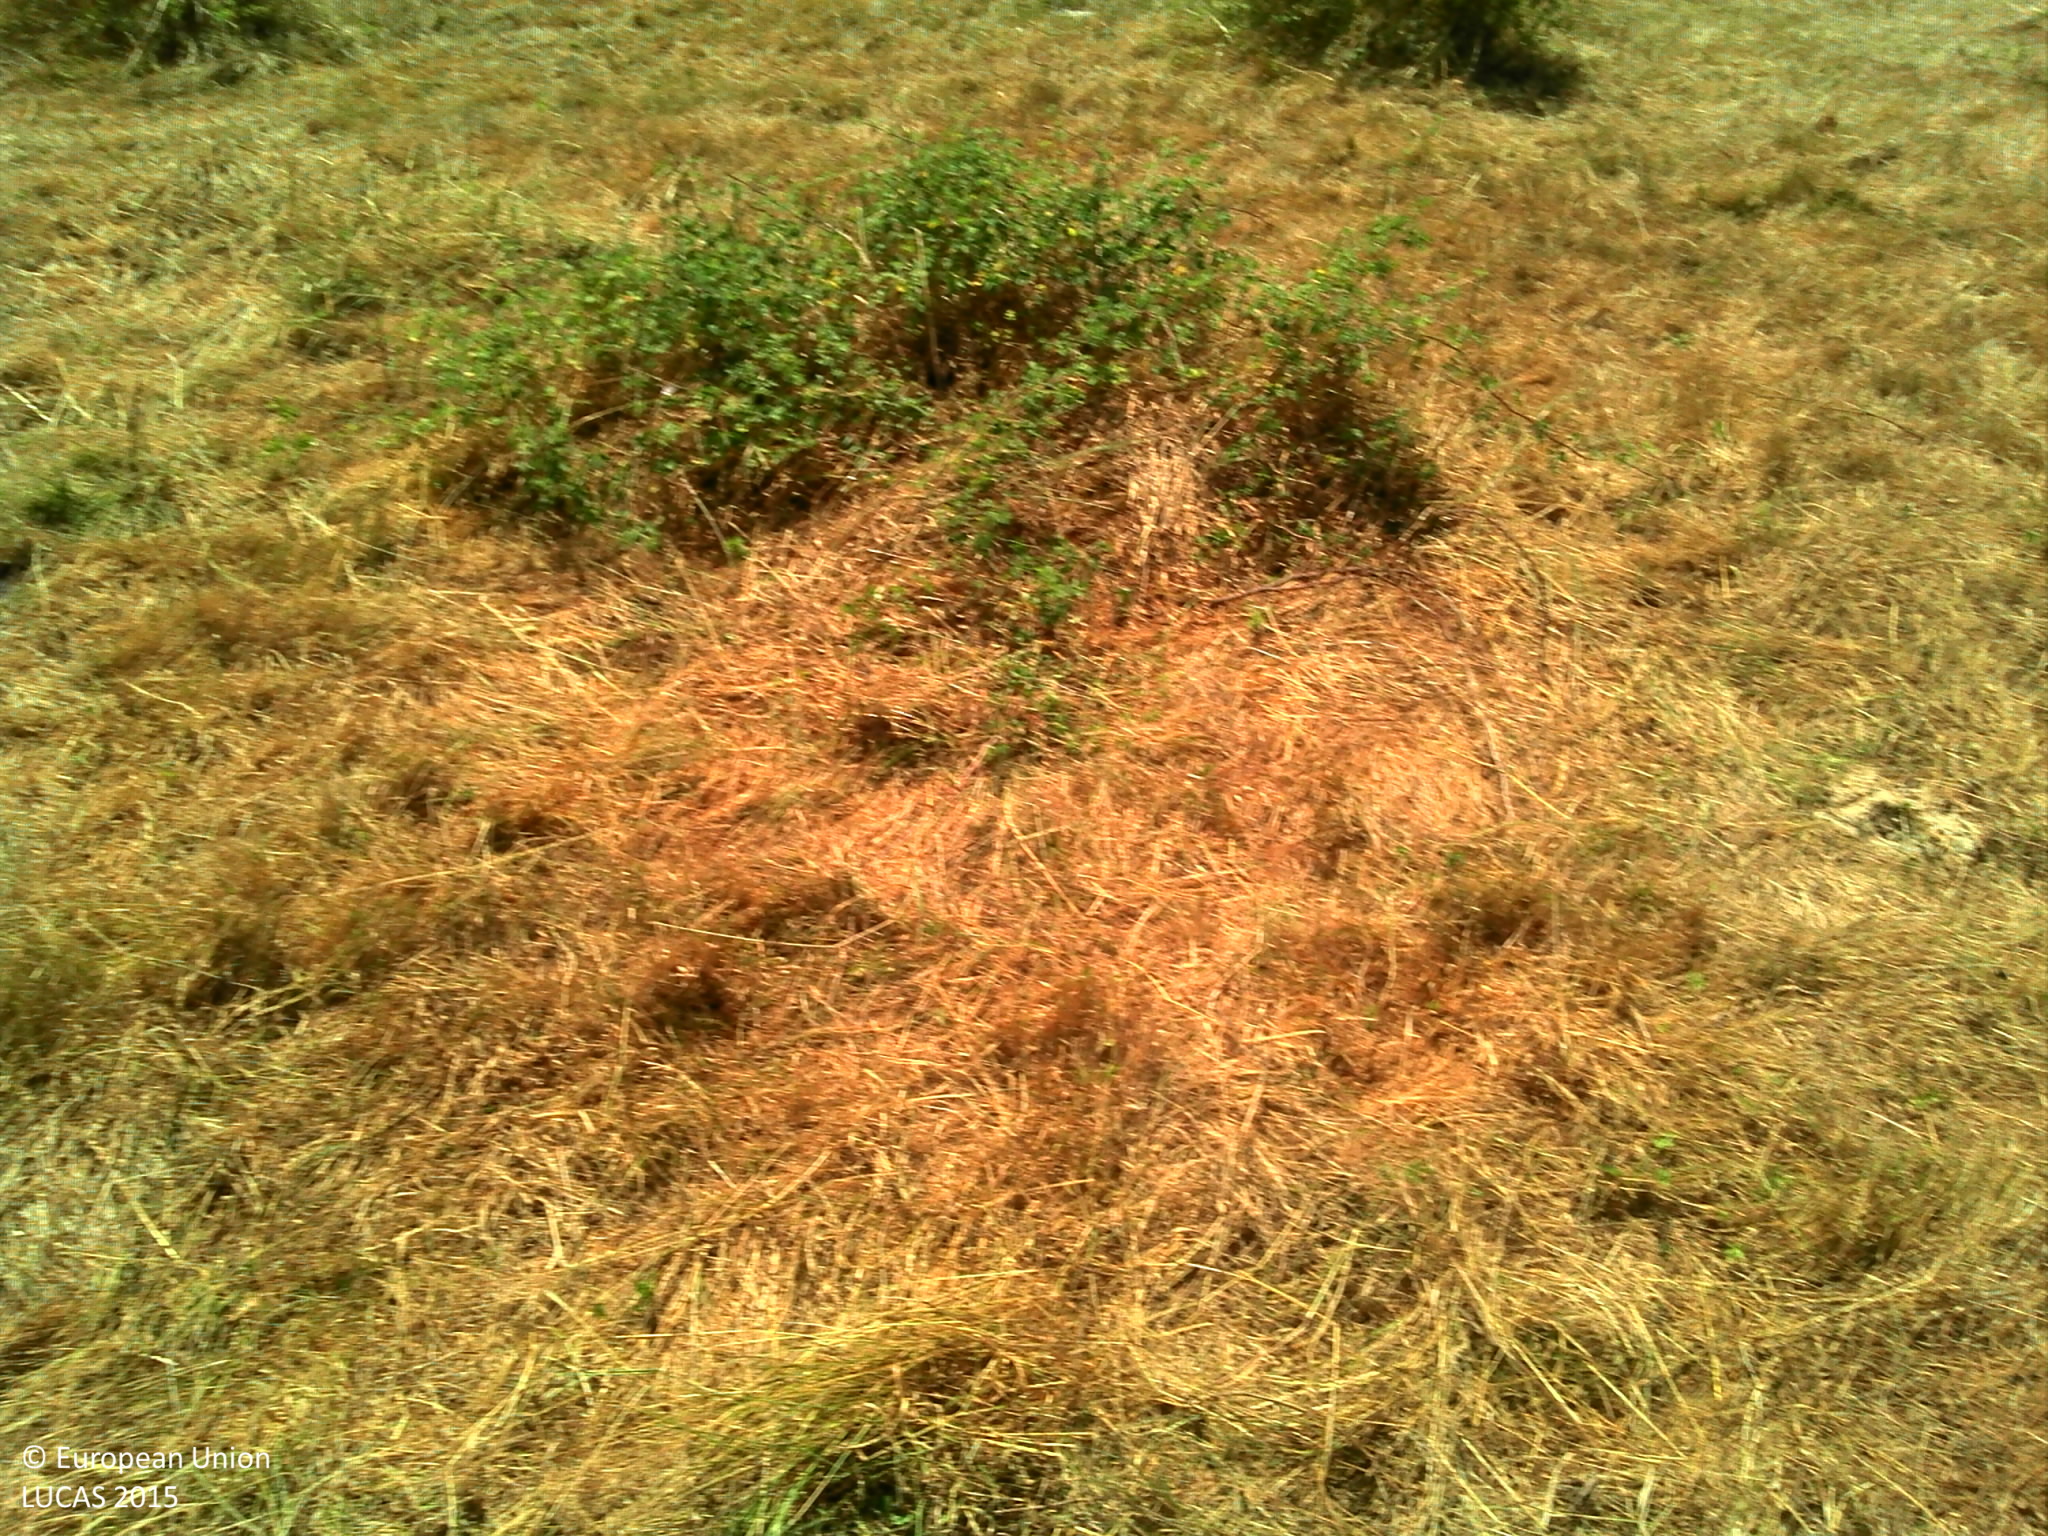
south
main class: Grassland
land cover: Grassland without tree/shrub cover
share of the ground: > 75 %
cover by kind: herbaceous plants 95 %, shrubs 5 %
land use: Agriculture (excluding fallow land and kitchen gardens)
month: July
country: FR
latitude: 46.8645
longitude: 3.6097
